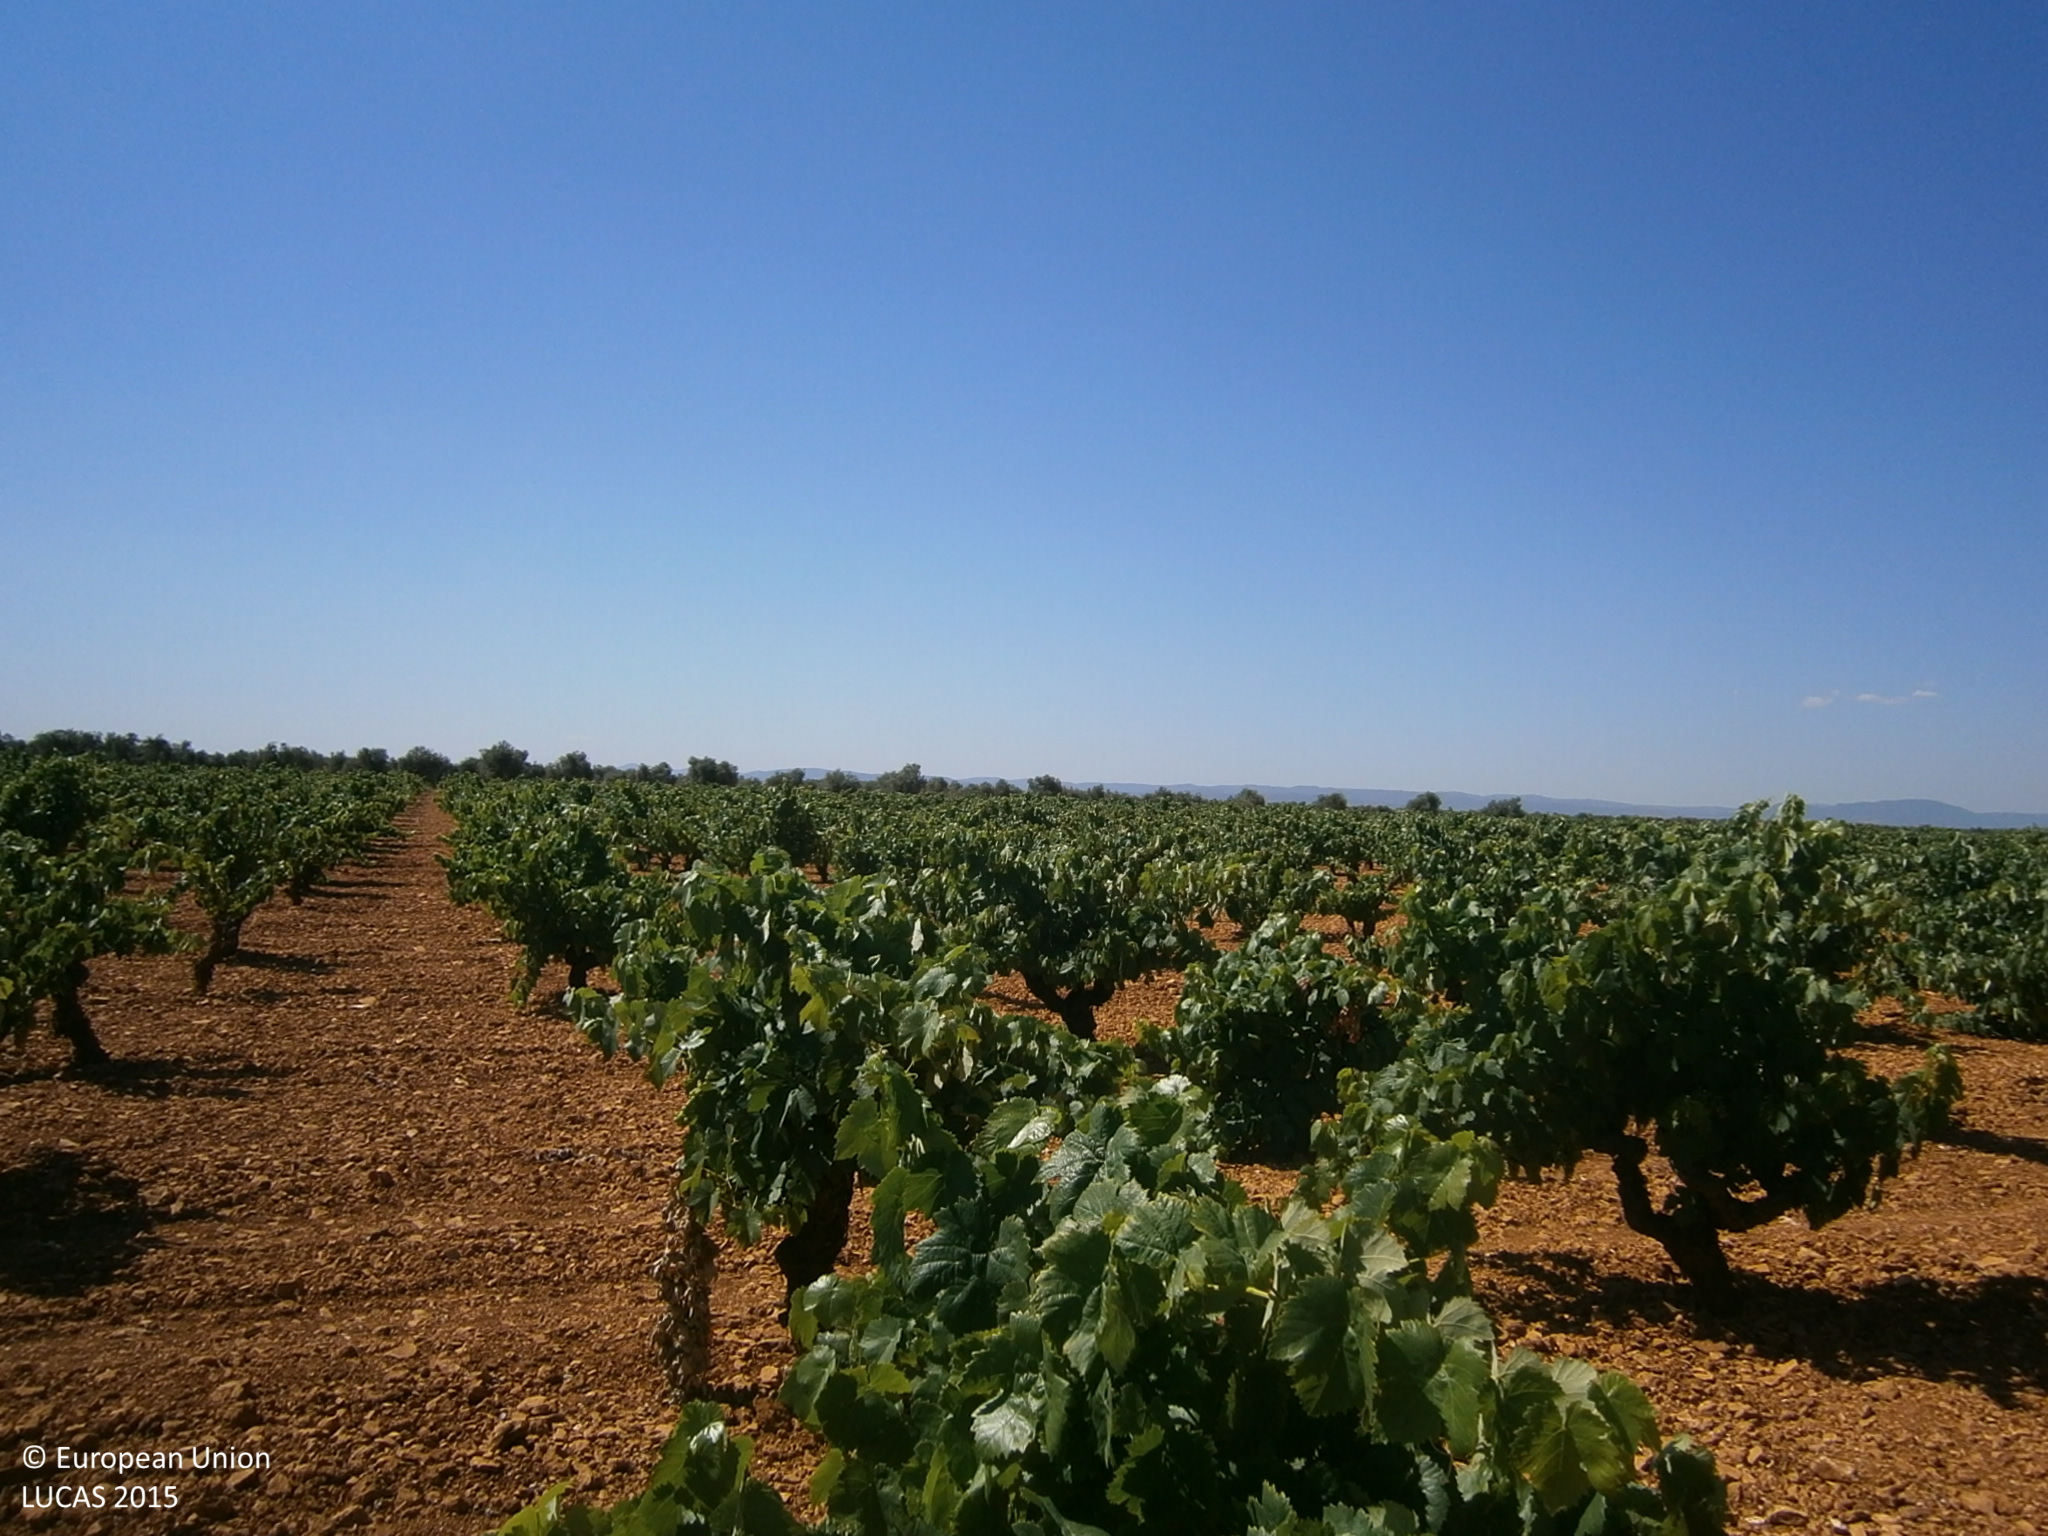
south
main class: Cropland
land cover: Vineyards
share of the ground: 25 - 50 %
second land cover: Other bare soil
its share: > 75 %
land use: Agriculture (excluding fallow land and kitchen gardens)
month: June
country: ES
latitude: 38.7567
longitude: -6.6664
